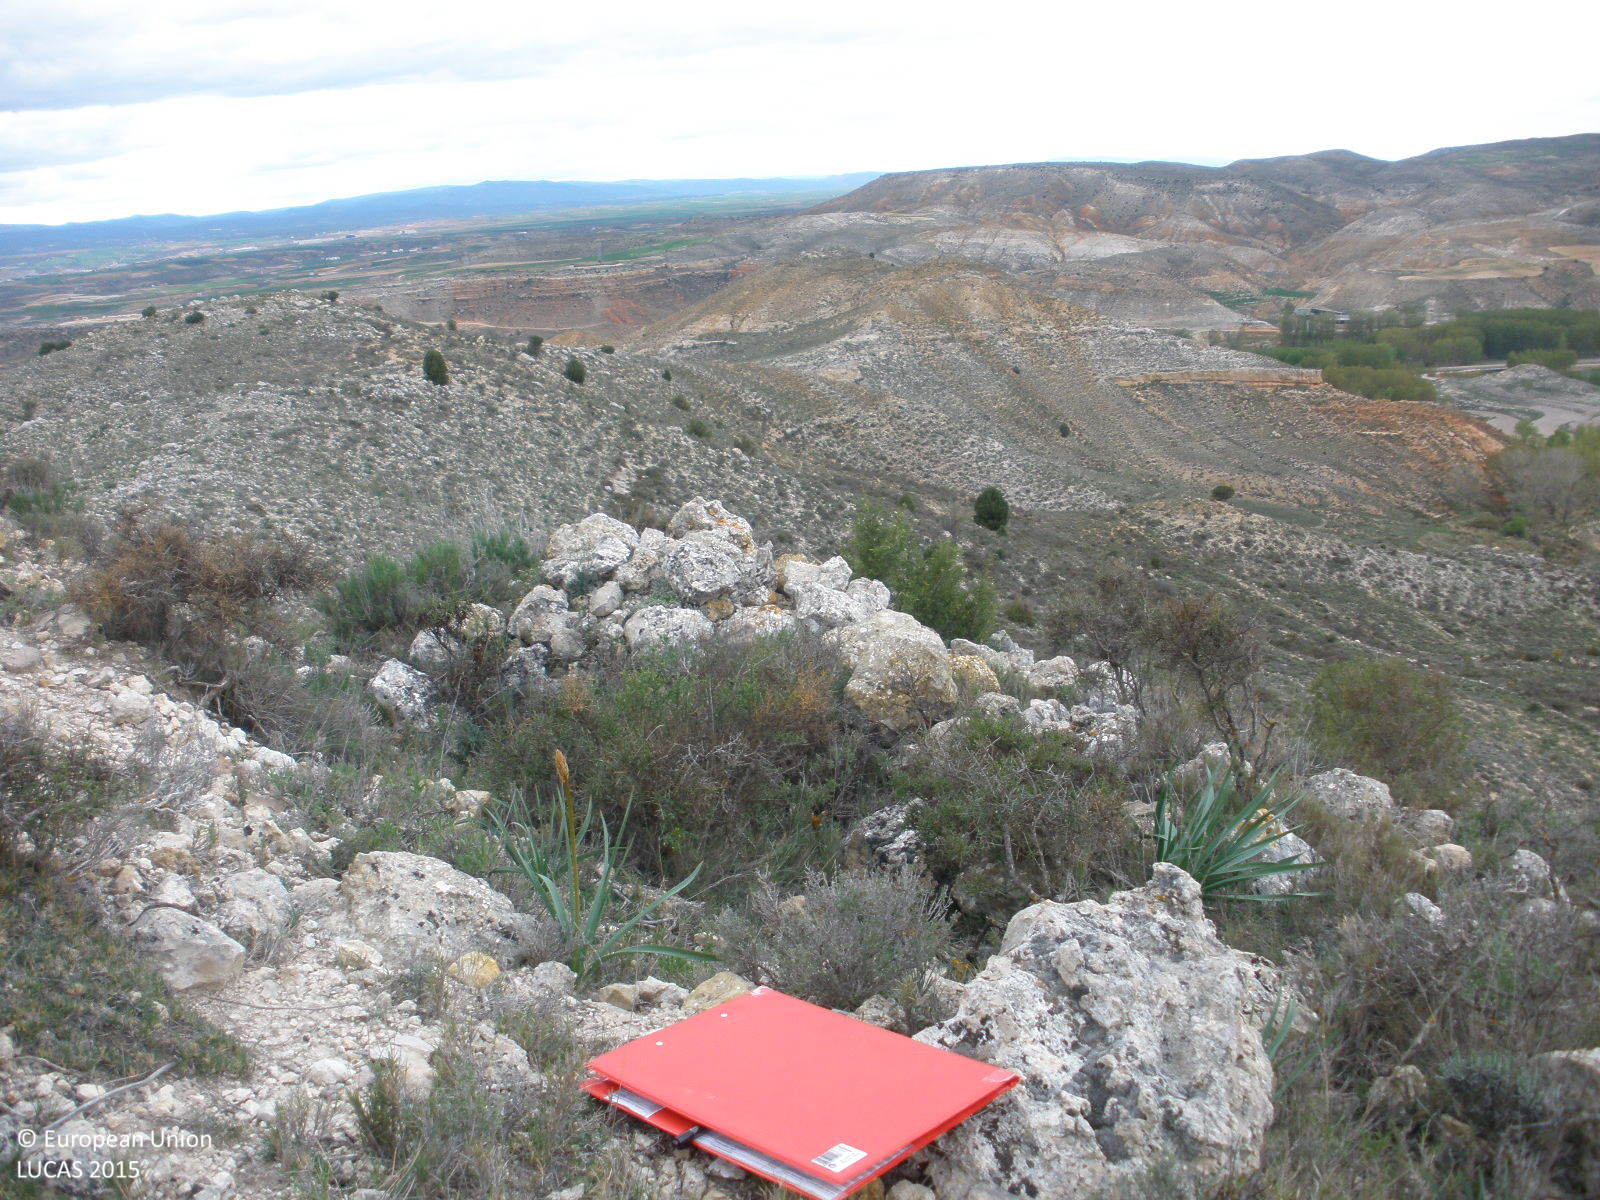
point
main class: Shrubland
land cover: Shrubland without tree cover
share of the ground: 25 - 50 %
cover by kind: shrubs 40 %, consolidated bare surface 40 %, herbaceous plants 20 %
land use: Semi-natural and natural areas not in use
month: April
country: ES
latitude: 40.3866
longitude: -1.0722
